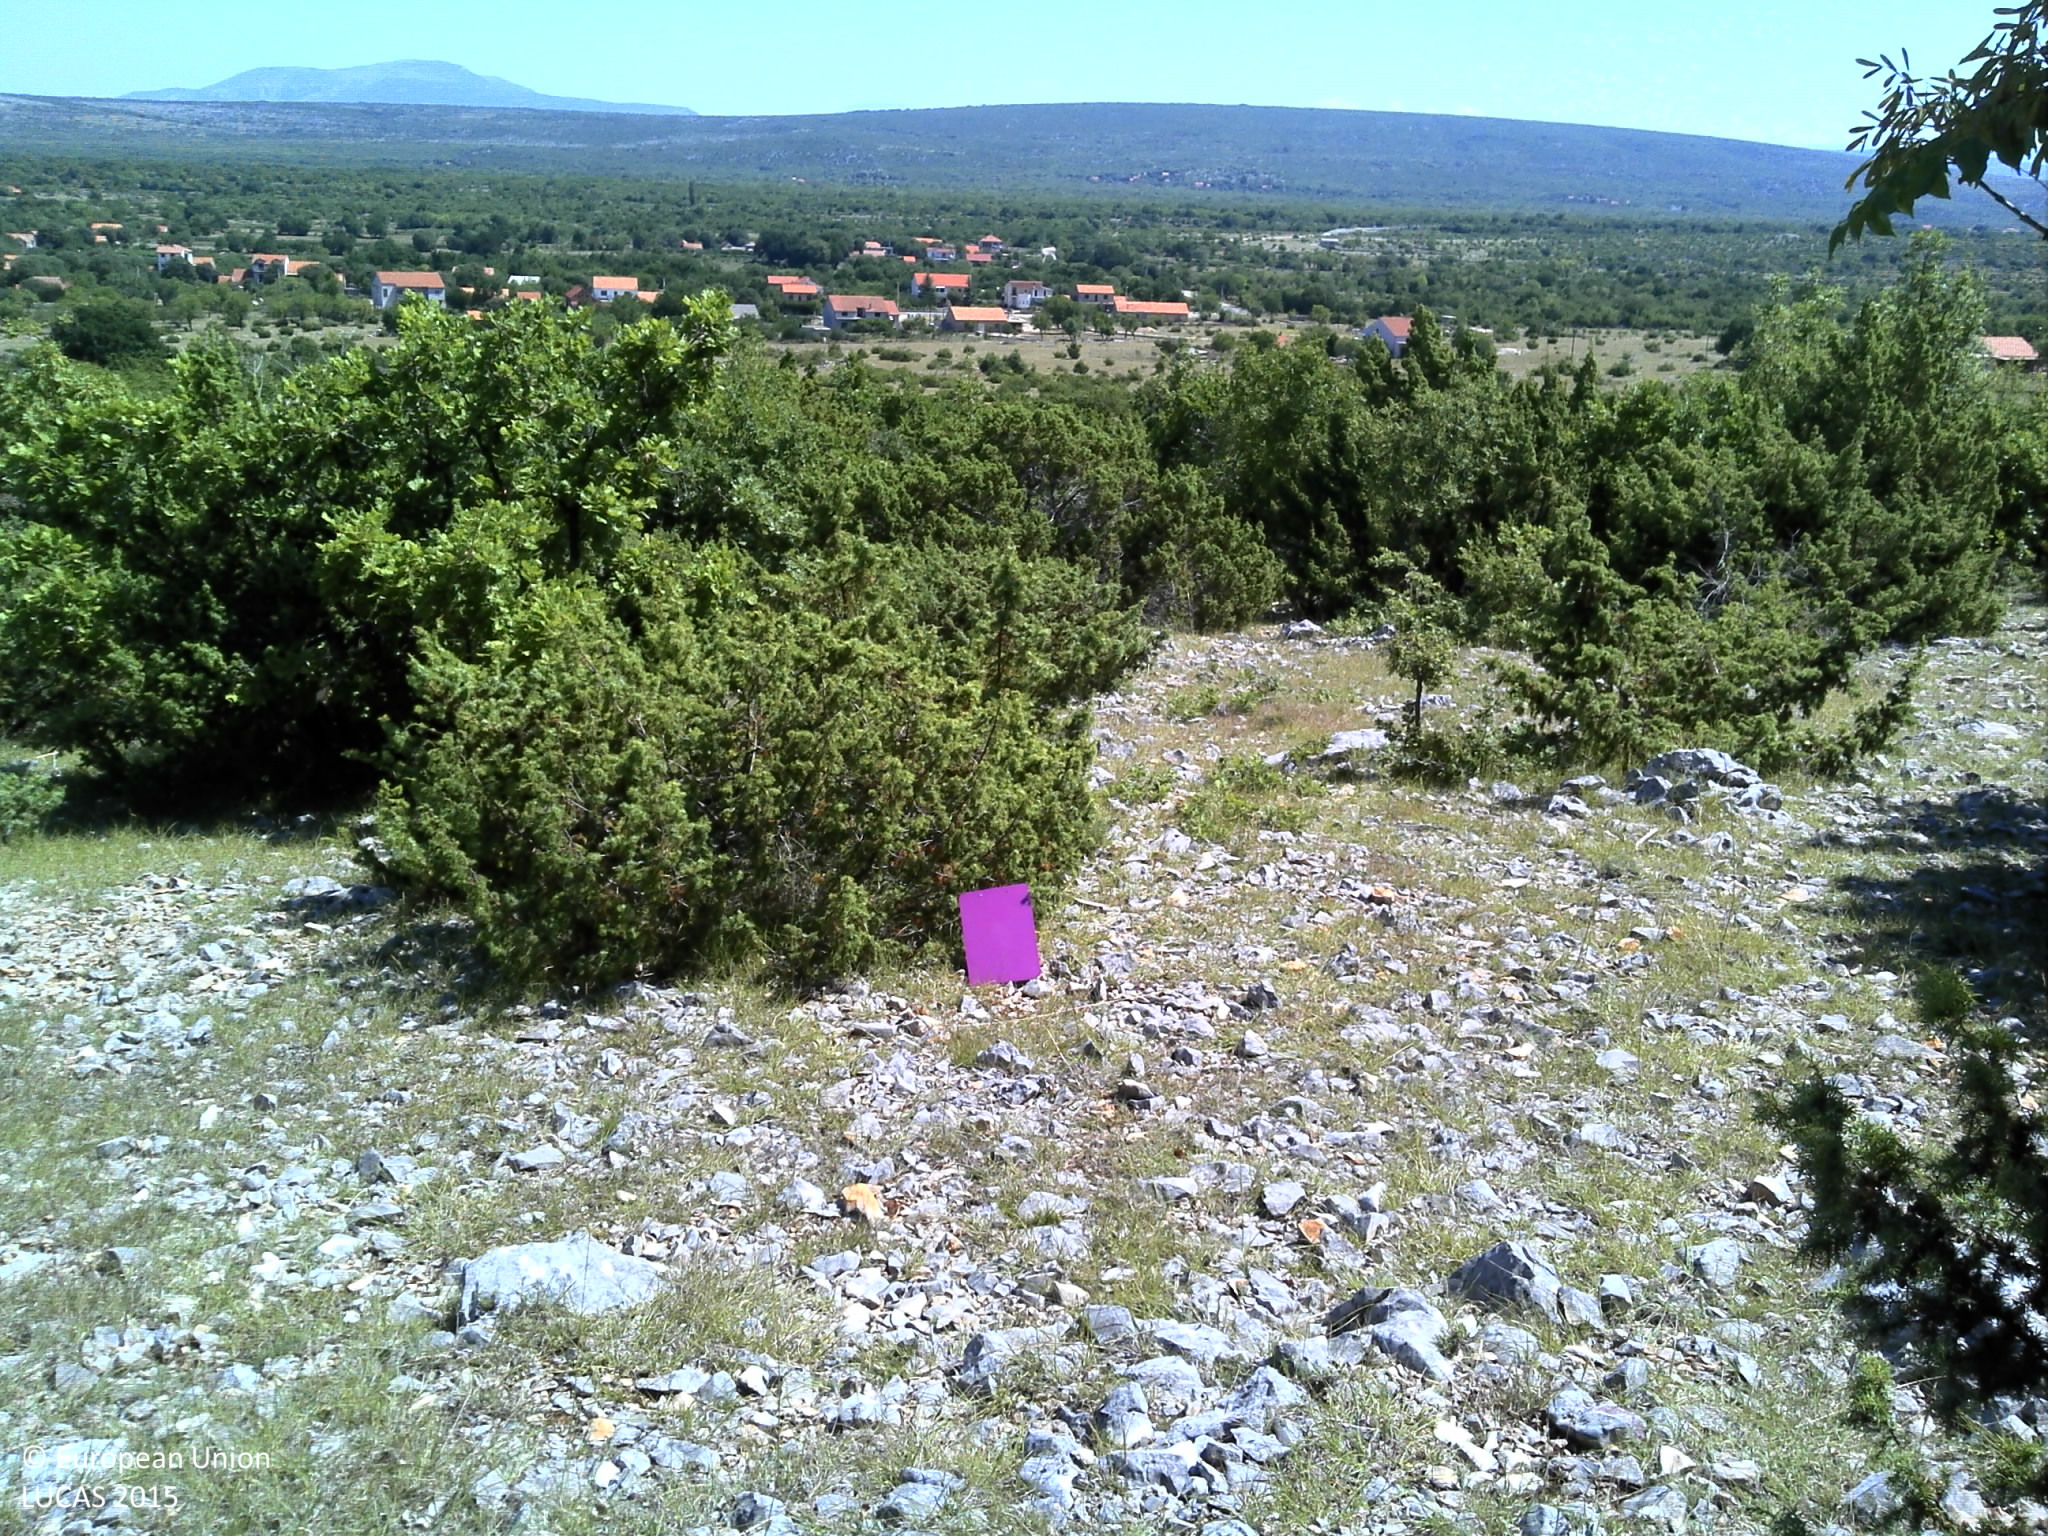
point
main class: Shrubland
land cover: Shrubland with sparse tree cover
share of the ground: 50 - 75 %
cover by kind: shrubs 60 %, unconsolidated bare surface 25 %, consolidated bare surface 10 %, broadleaved forest trees 5 %
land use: Semi-natural and natural areas not in use
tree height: < 5 m
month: July
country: HR
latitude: 43.7572
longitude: 16.0648
